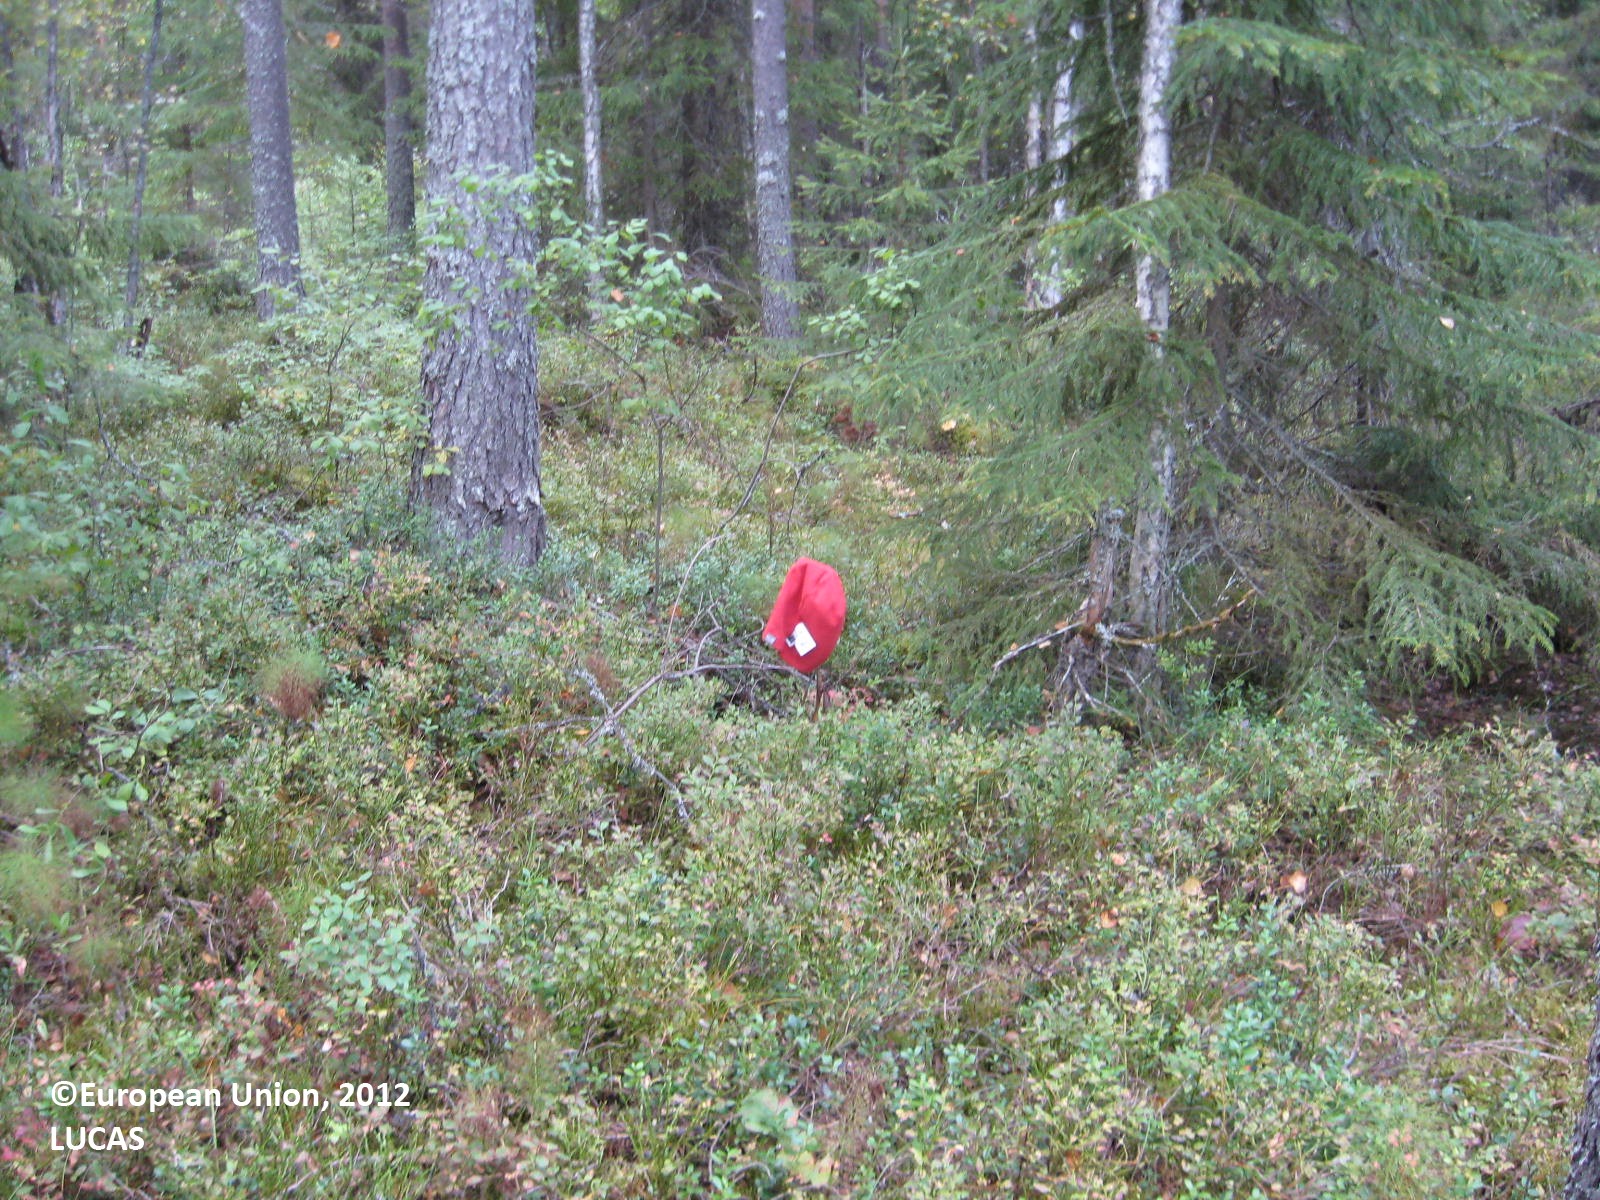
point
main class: Woodland
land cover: Pine dominated mixed woodland
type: boreal forest
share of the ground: 50 - 75 %
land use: Forestry
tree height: > 5 m
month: August
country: FI
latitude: 63.6409
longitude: 29.4623
